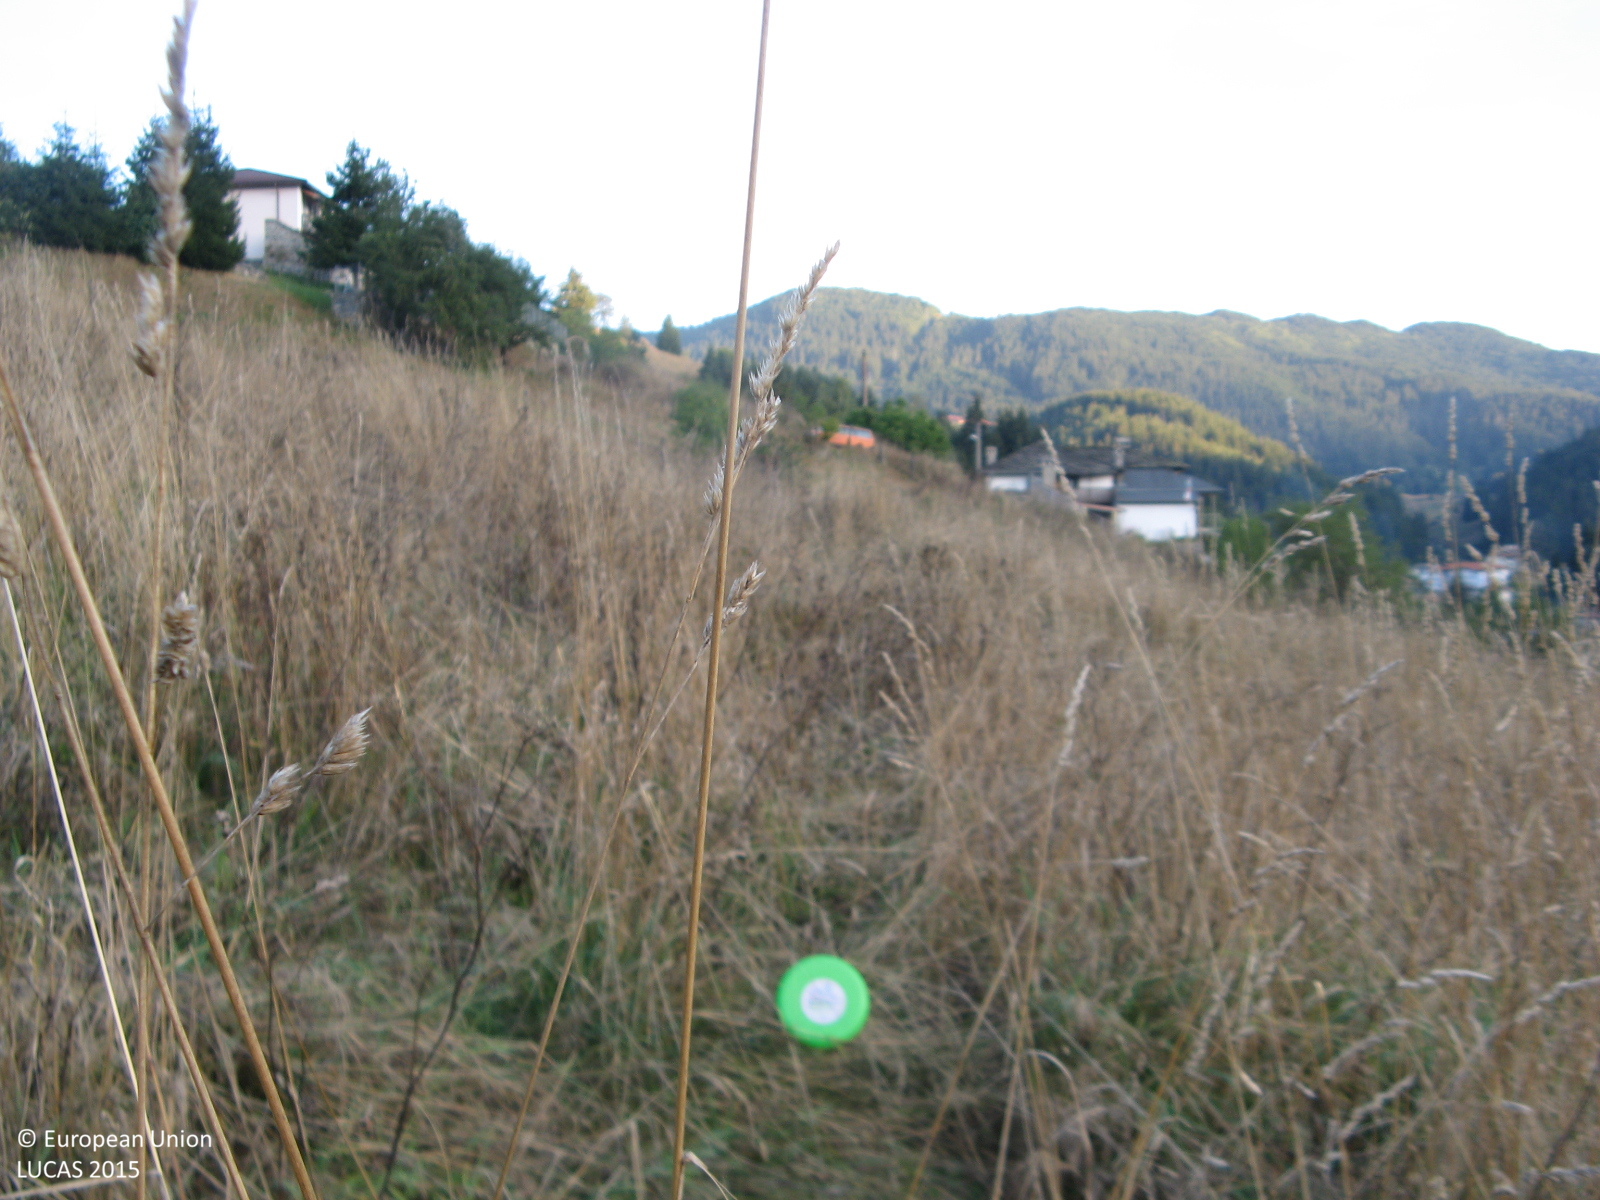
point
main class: Grassland
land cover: Grassland without tree/shrub cover
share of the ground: > 75 %
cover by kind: herbaceous plants 100 %
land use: Agriculture (excluding fallow land and kitchen gardens)
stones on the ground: < 10 %
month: October
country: BG
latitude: 41.6579
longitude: 24.6341
